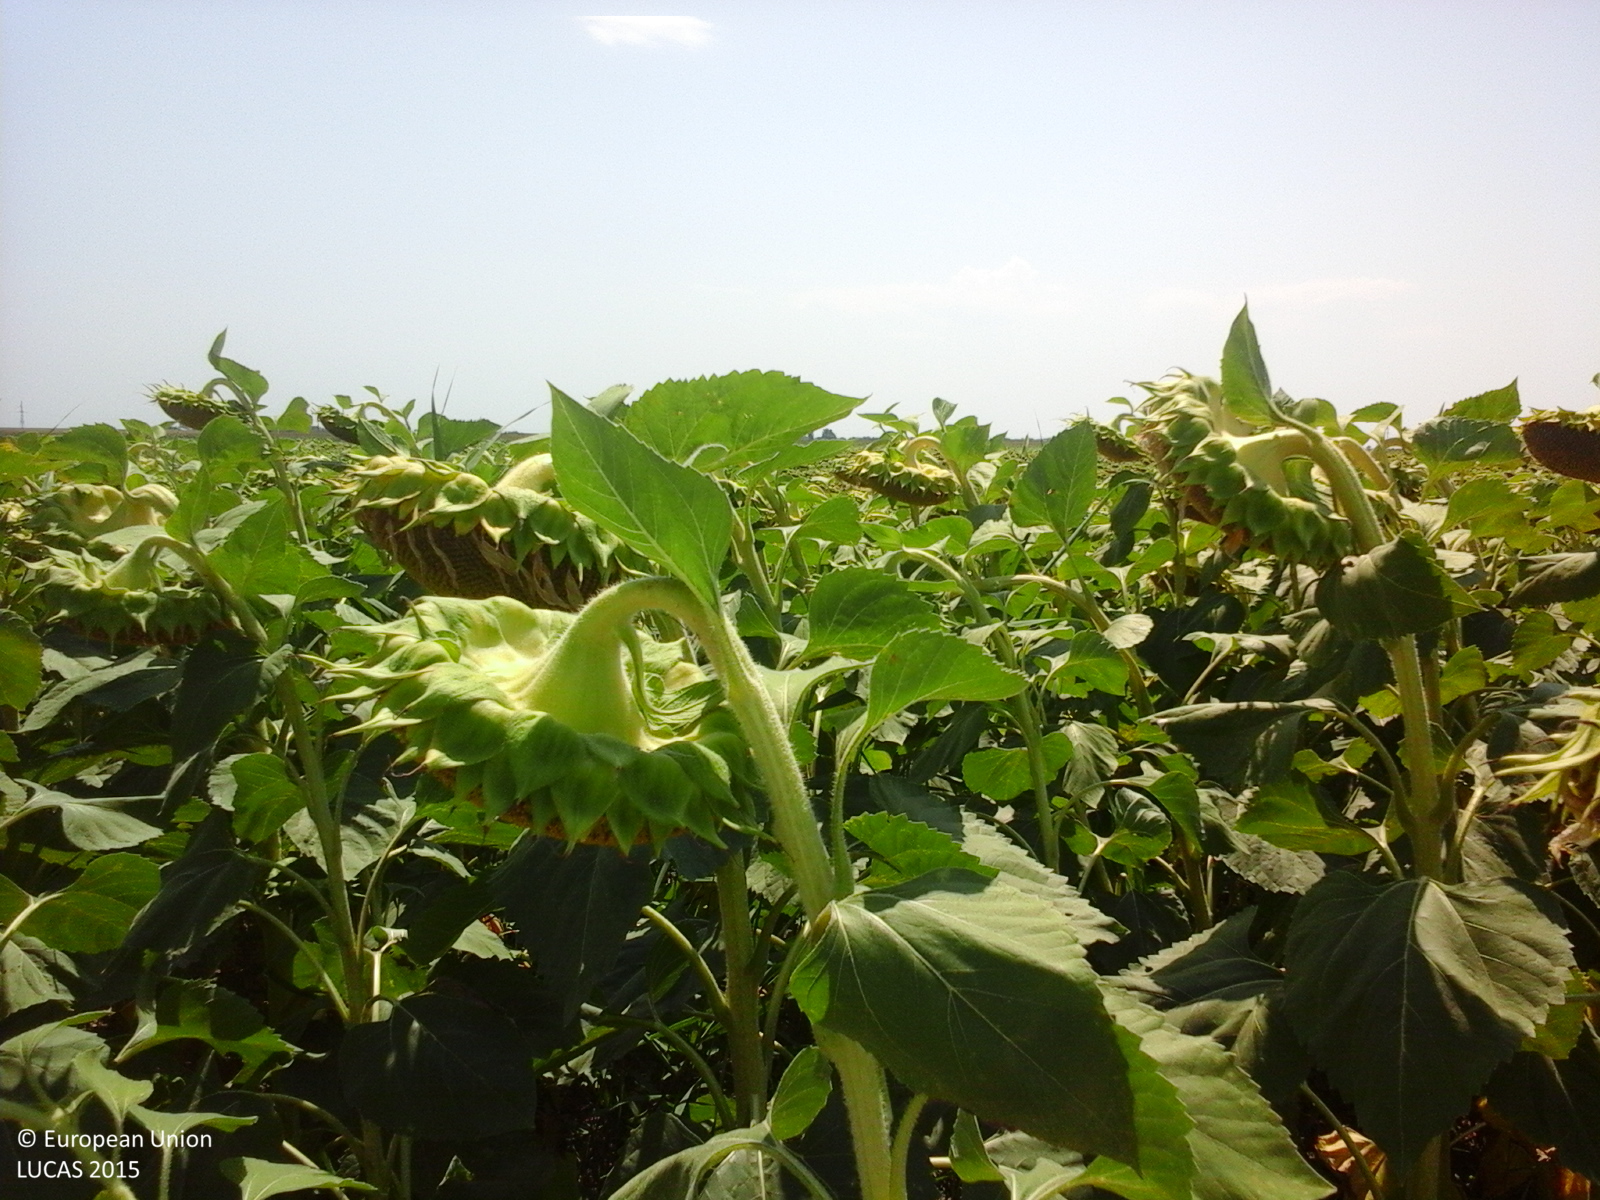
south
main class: Cropland
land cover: Sunflower
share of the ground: > 75 %
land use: Agriculture (excluding fallow land and kitchen gardens)
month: August
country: RO
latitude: 45.3121
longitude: 27.7487
